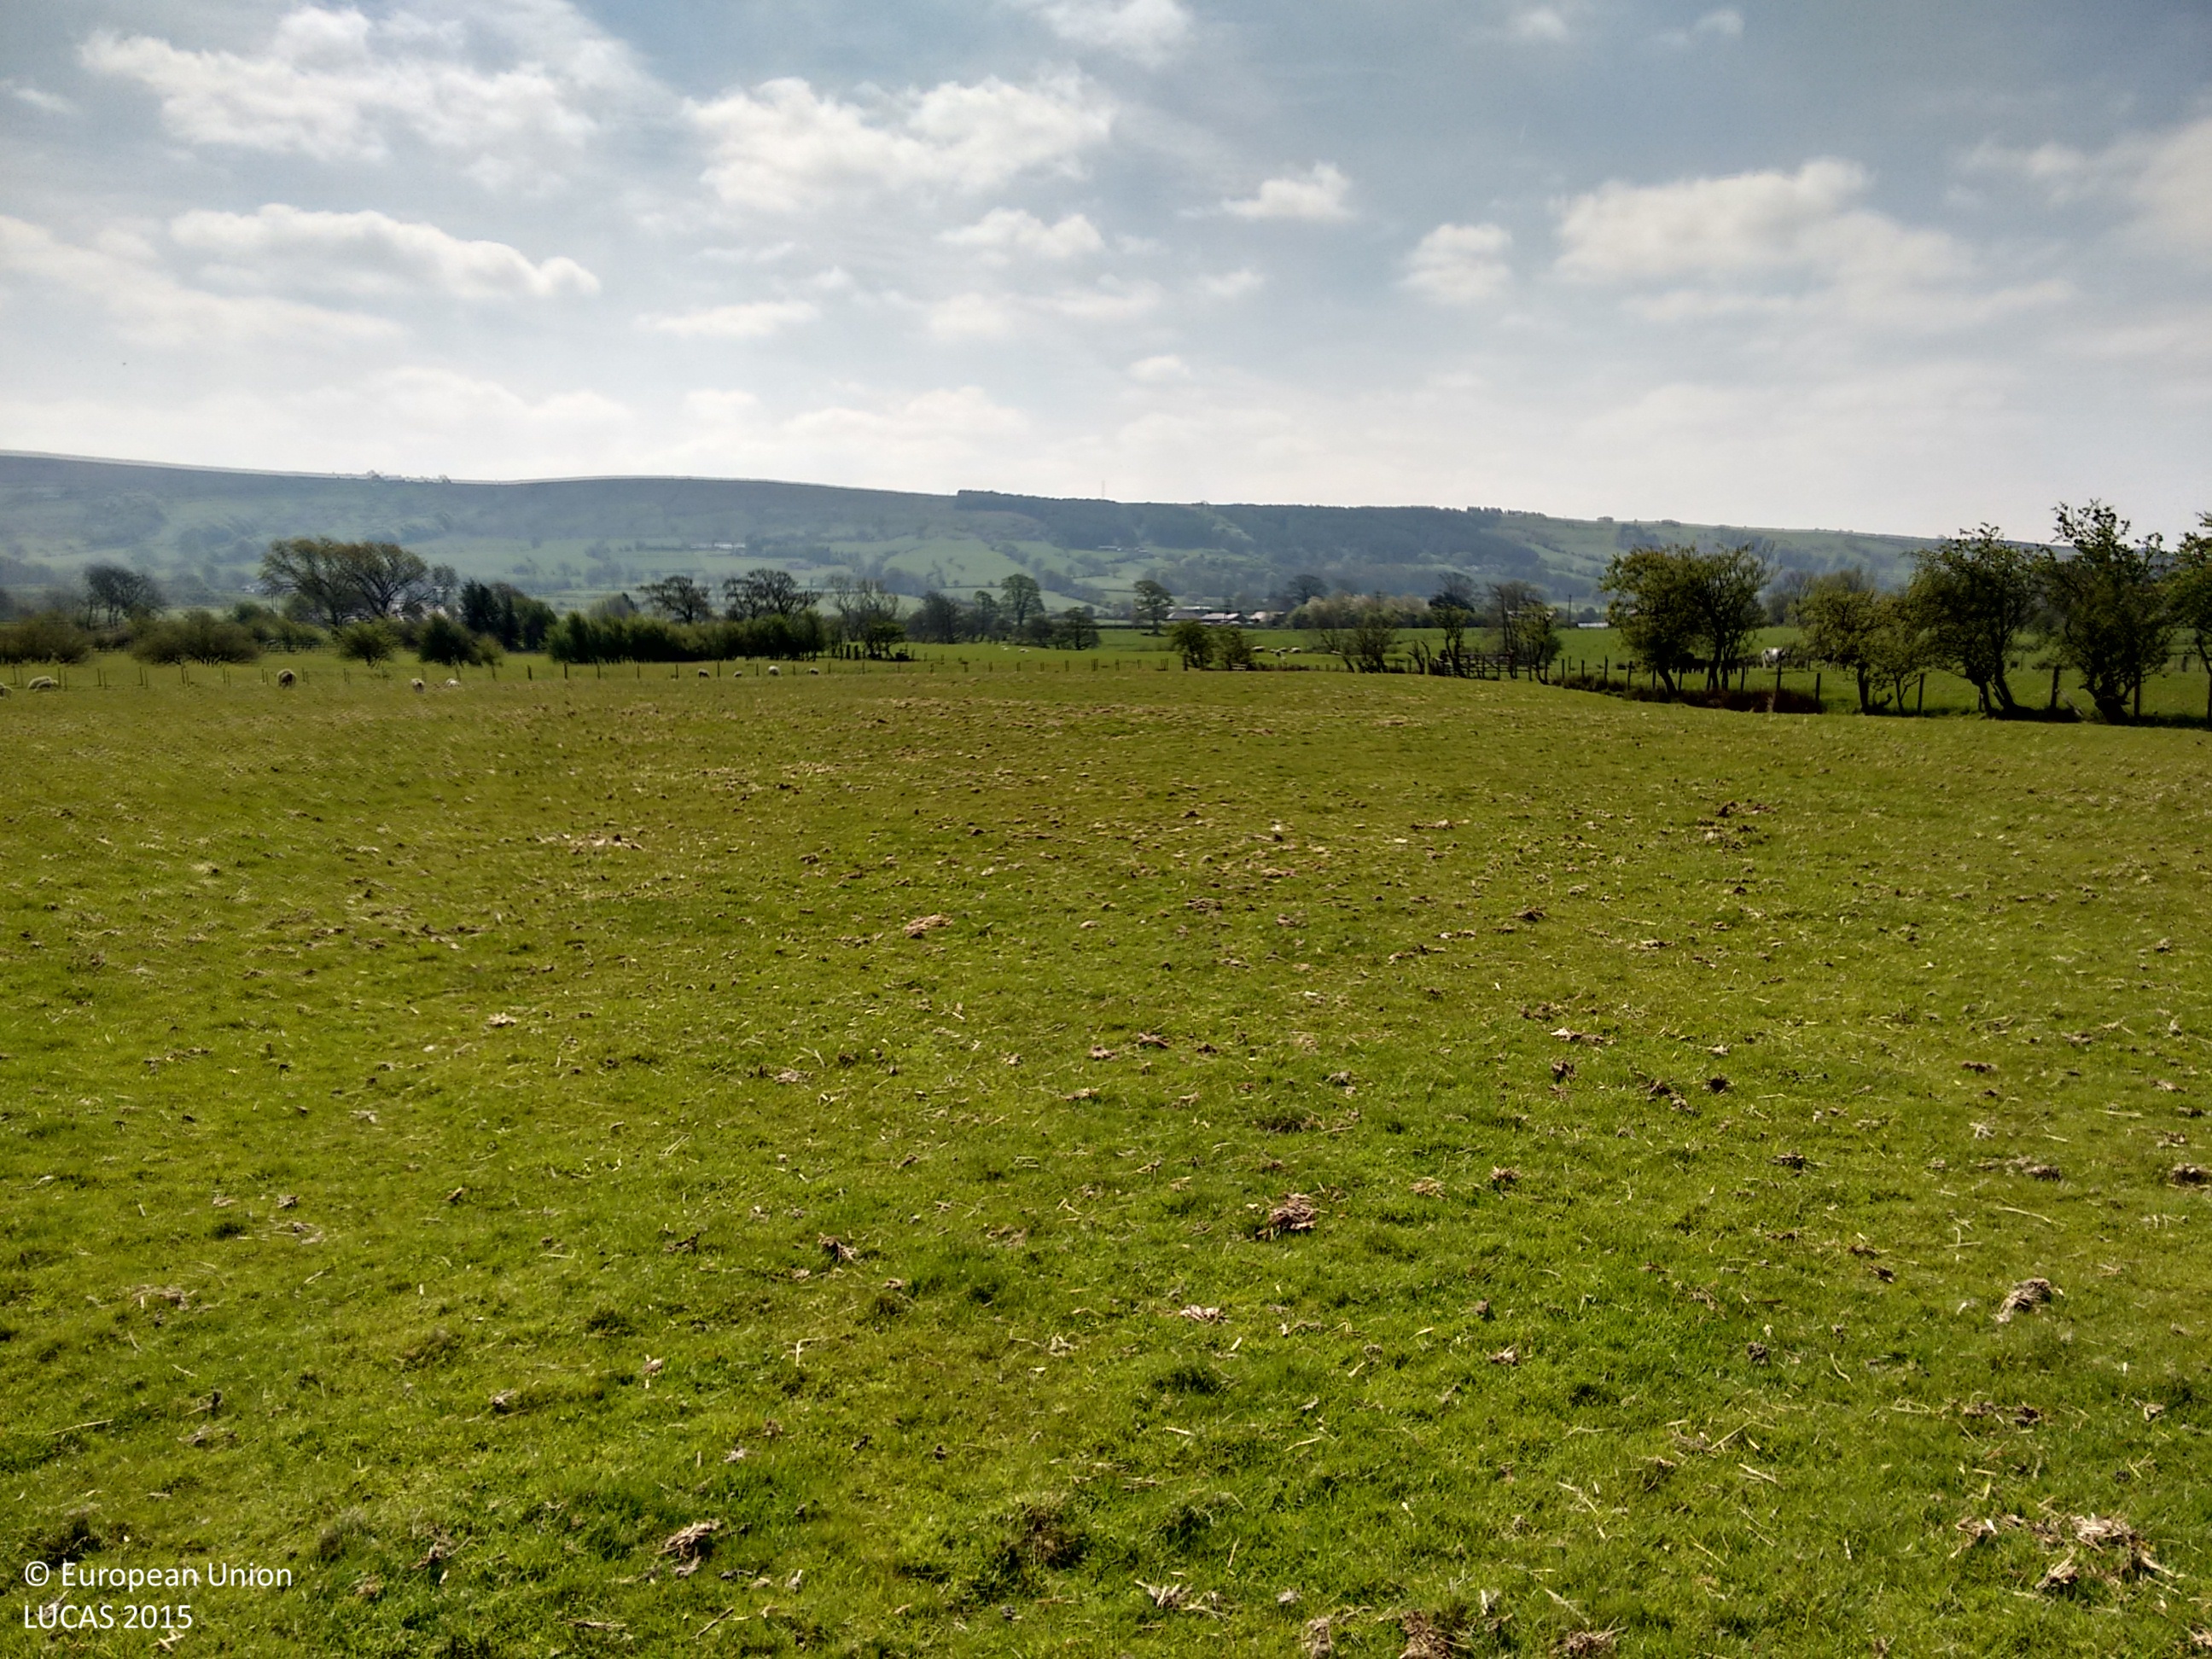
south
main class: Grassland
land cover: Grassland without tree/shrub cover
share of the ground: > 75 %
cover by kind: herbaceous plants 100 %
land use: Agriculture (excluding fallow land and kitchen gardens)
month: May
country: GB
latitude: 53.8712
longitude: -2.5831
